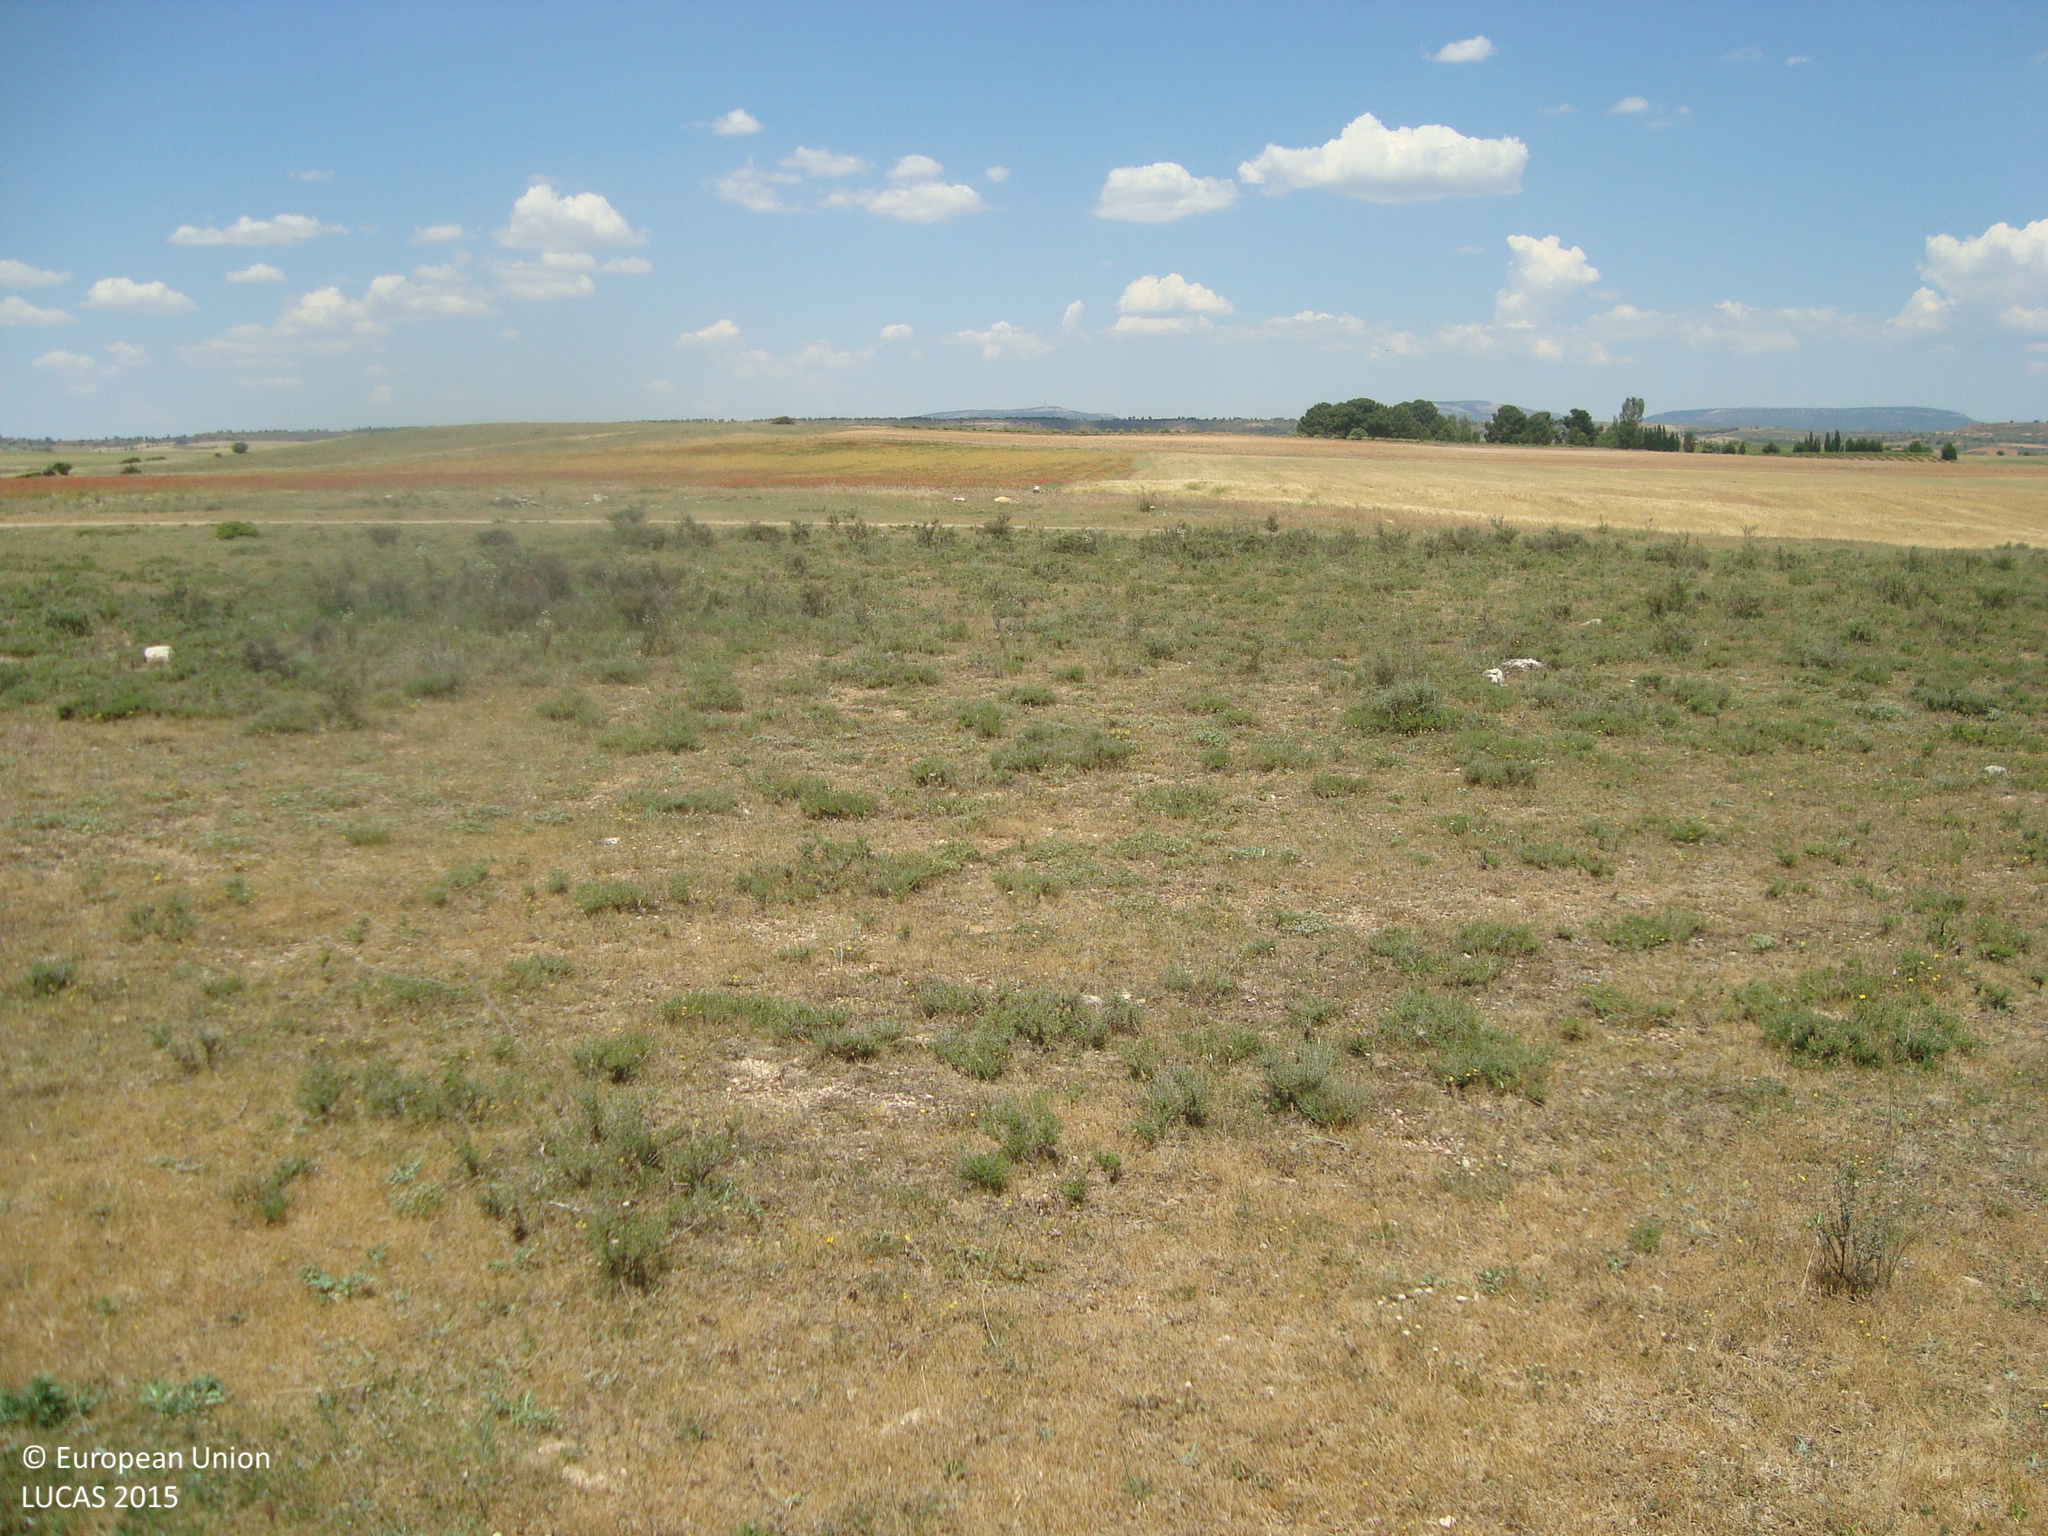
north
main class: Grassland
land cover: Spontaneously vegetated surfaces
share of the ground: 25 - 50 %
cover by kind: unconsolidated bare surface 75 %, herbaceous plants 25 %
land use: Agriculture (excluding fallow land and kitchen gardens)
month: June
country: ES
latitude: 41.7947
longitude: -3.5424
